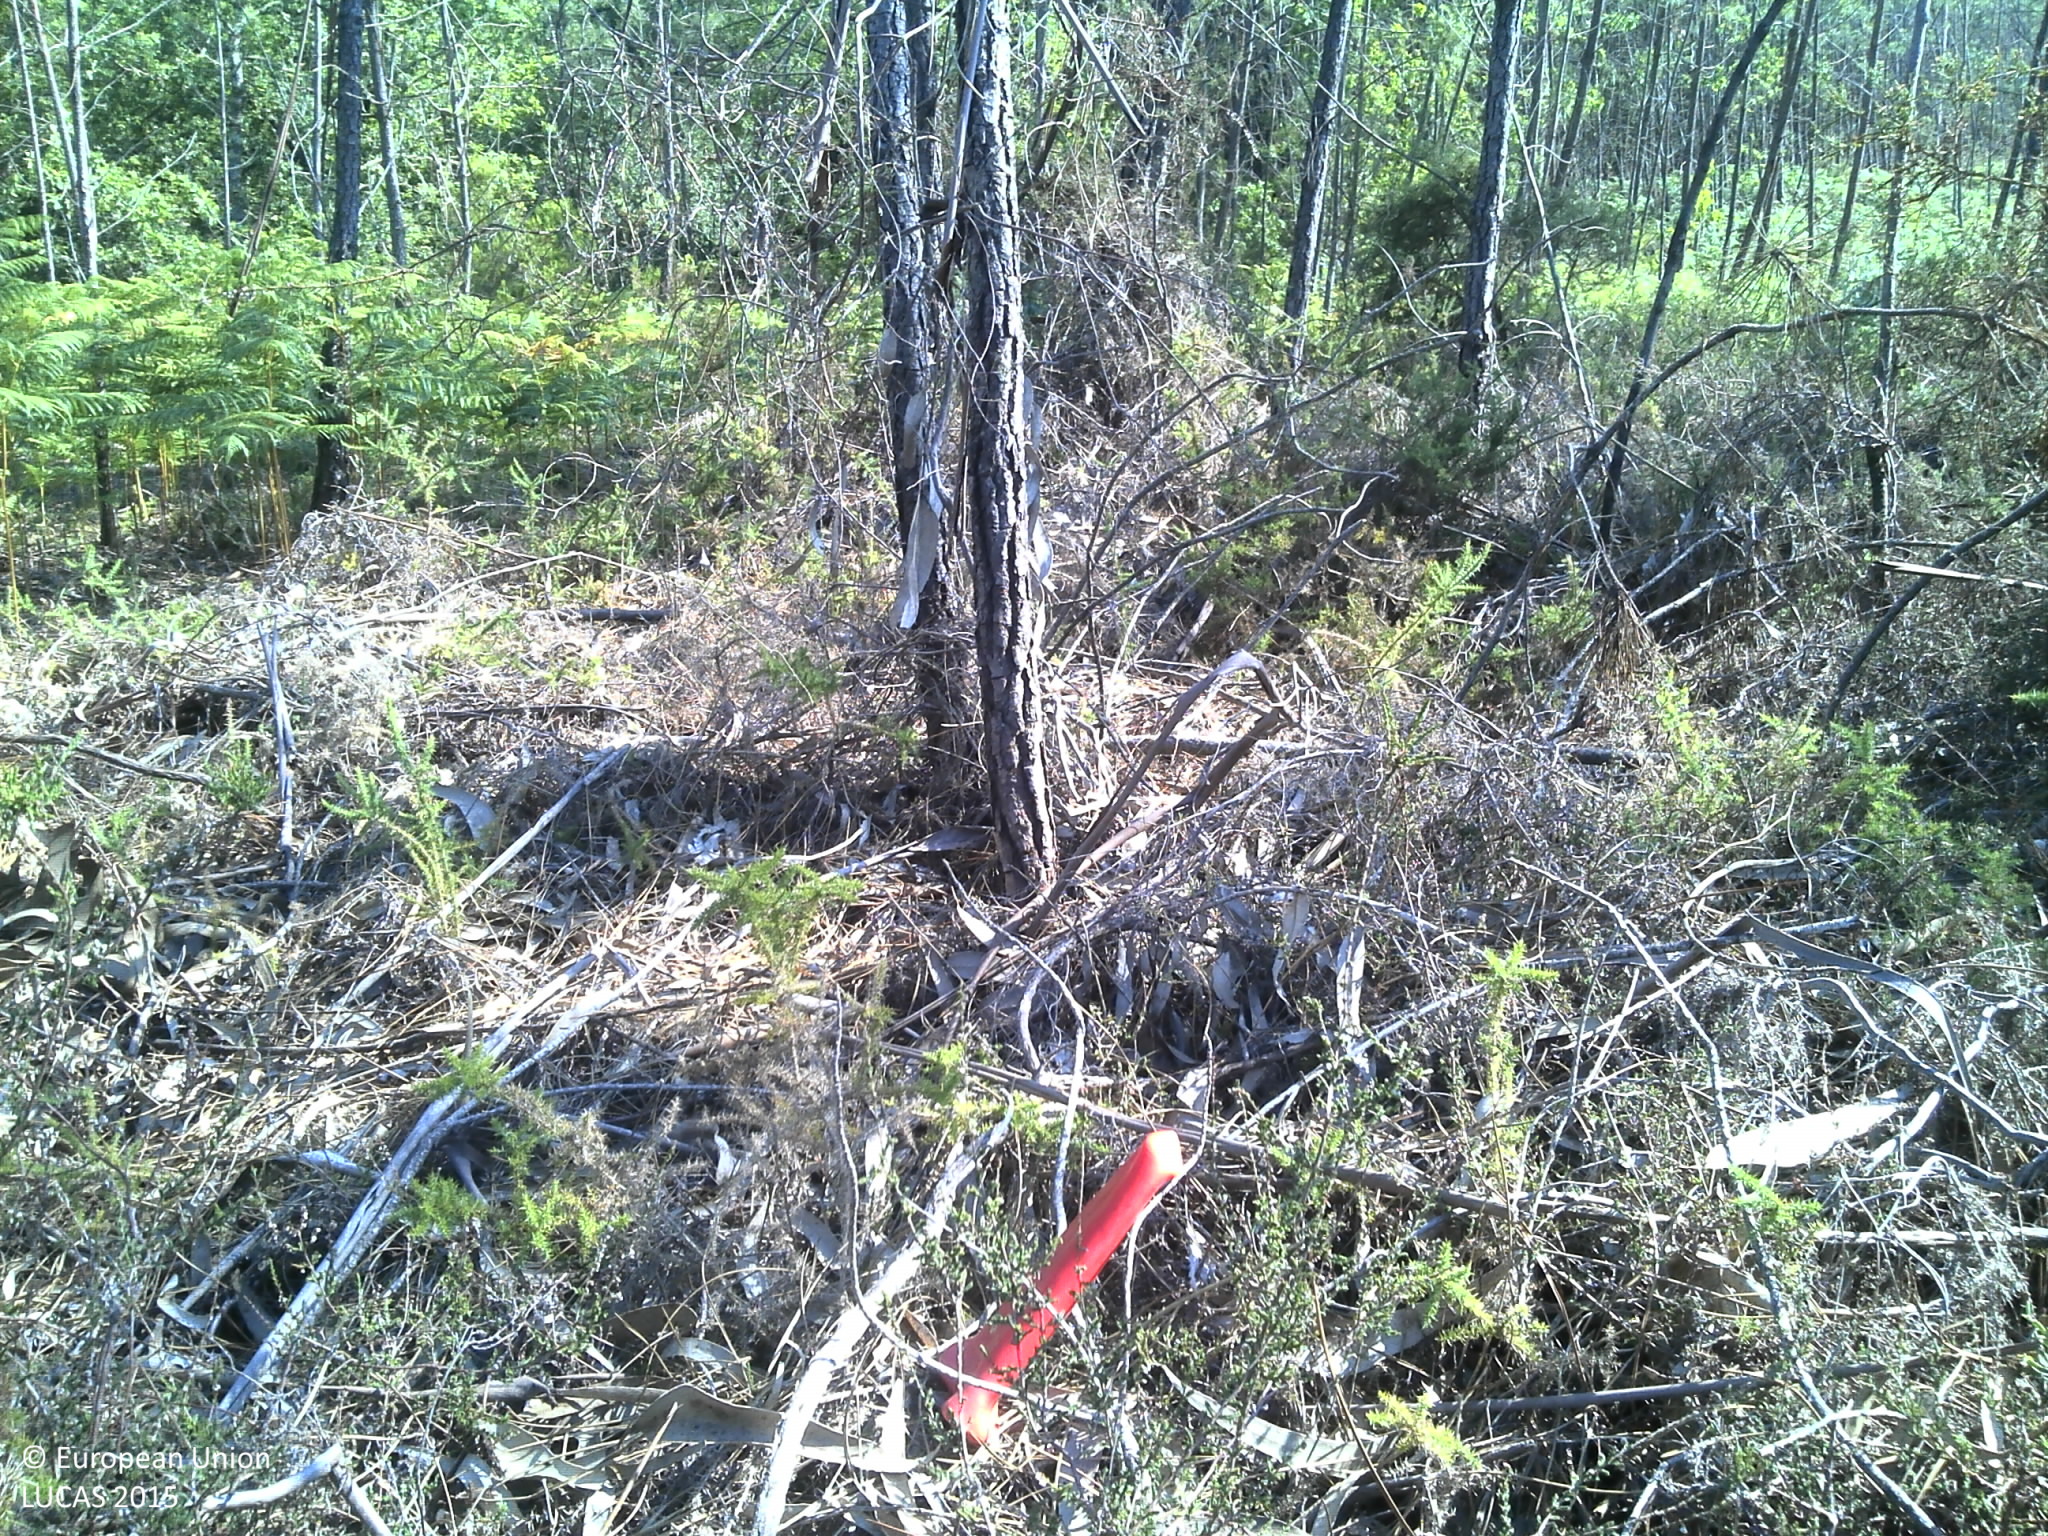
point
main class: Woodland
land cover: Pine dominated coniferous woodland
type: coniferous forest of the mediterranean region
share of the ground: 25 - 50 %
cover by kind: coniferous forest trees 45 %, shrubs 40 %, unconsolidated bare surface 10 %, herbaceous plants 5 %
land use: Forestry
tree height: > 5 m
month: June
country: PT
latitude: 40.6307
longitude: -8.0388
